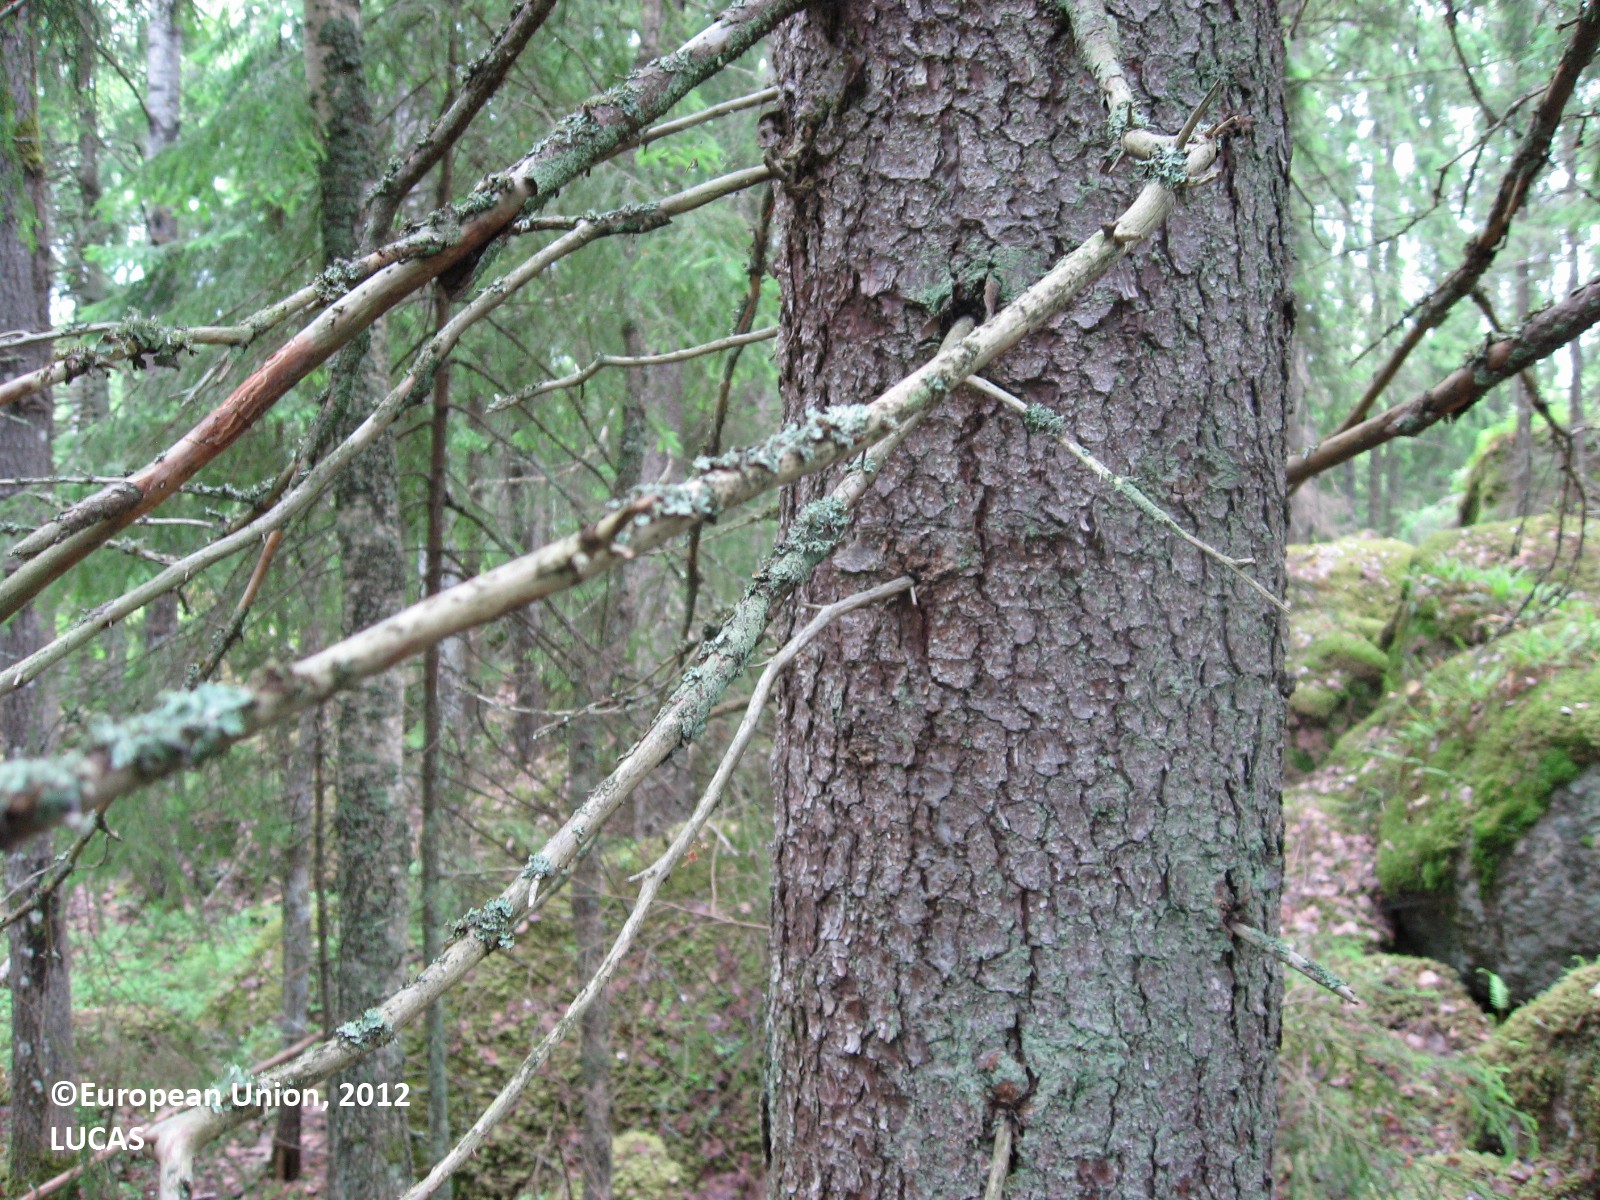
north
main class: Woodland
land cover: Spruce dominated coniferous woodland
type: boreal forest
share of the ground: > 75 %
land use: Forestry
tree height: > 5 m
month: June
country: FI
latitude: 60.4137
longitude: 26.3674
